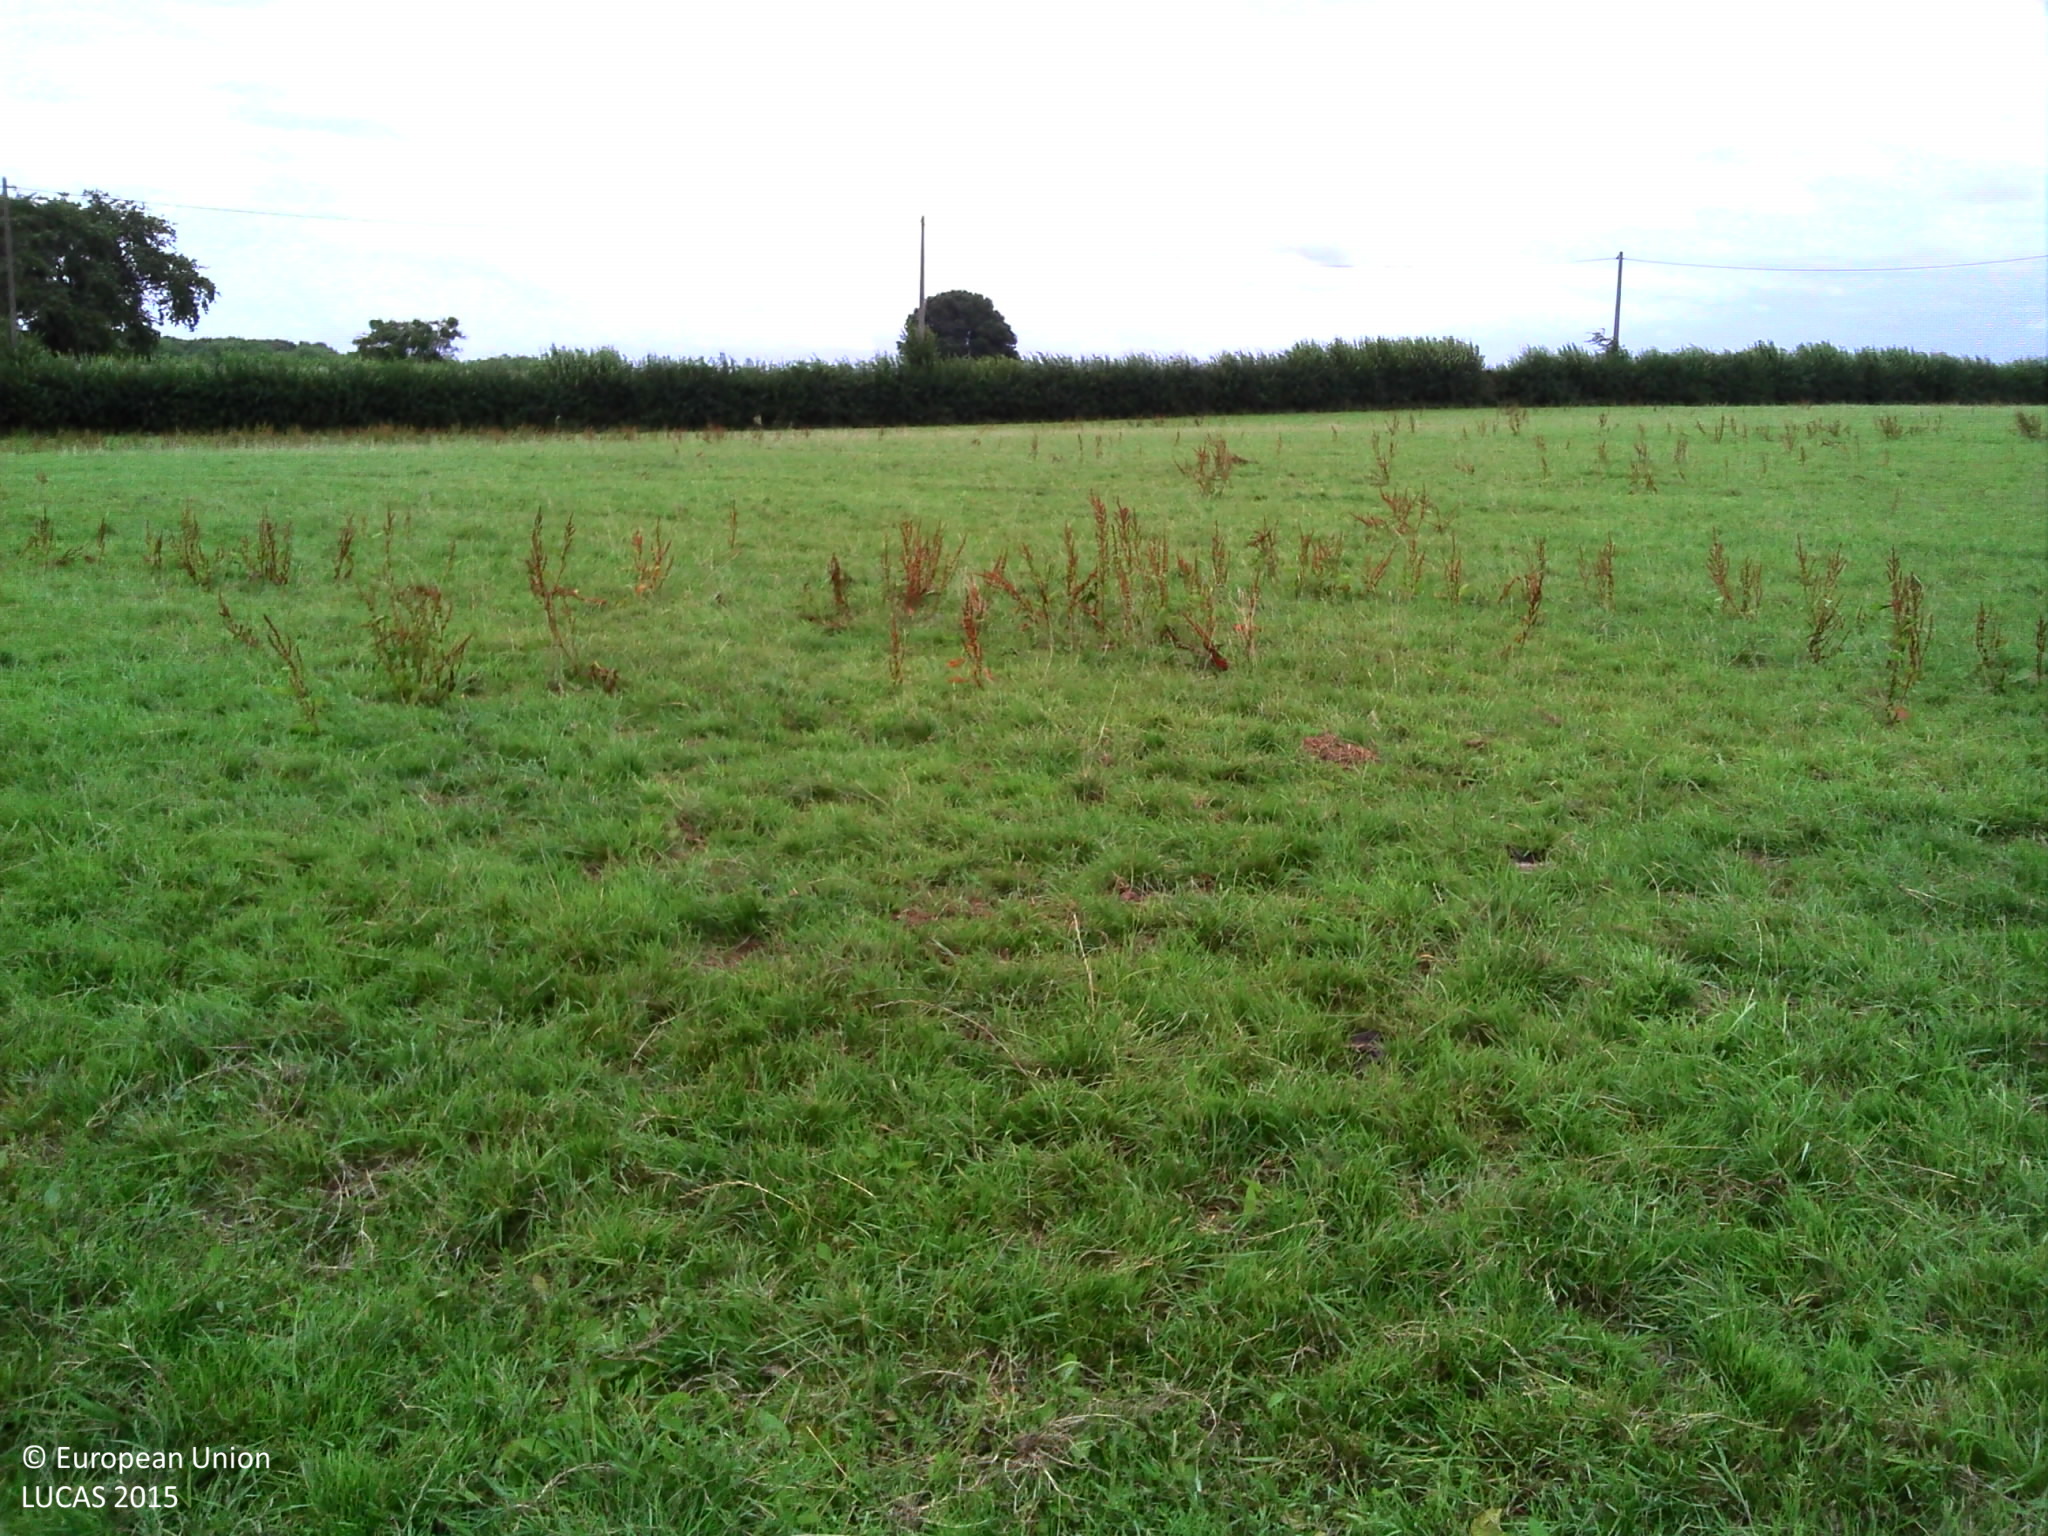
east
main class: Grassland
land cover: Grassland without tree/shrub cover
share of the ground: > 75 %
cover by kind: herbaceous plants 95 %, lichens and mosses 5 %
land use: Agriculture (excluding fallow land and kitchen gardens)
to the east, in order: Grassland without tree/shrub cover; Fences; Electric lines; Abandoned hedges; Ditches and canals; Grass margins; Paved roads, cycling and walking lanes; Grass margins; Ditches and canals; Grass margins; Maize; Abandoned hedges; Grassland without tree/shrub cover
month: July
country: FR
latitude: 50.1517
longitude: 3.6532
